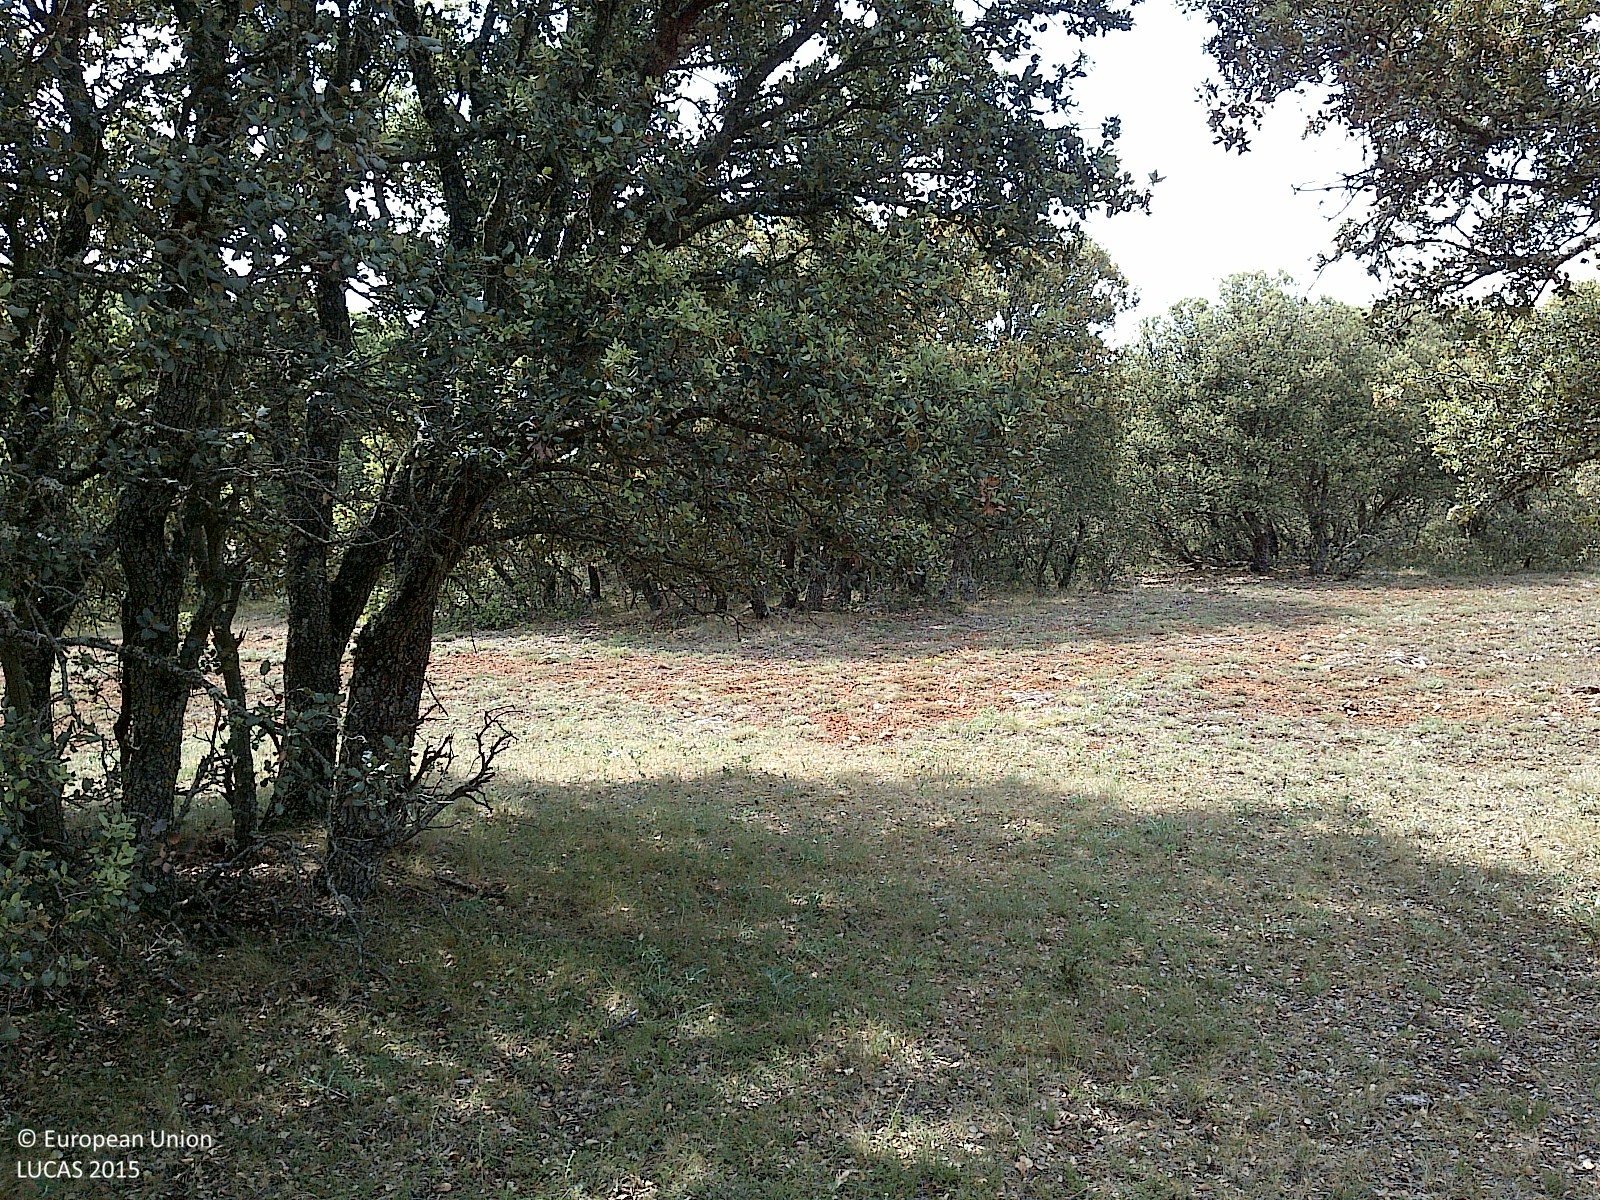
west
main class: Woodland
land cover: Broadleaved woodland
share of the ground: 50 - 75 %
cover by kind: broadleaved forest trees 50 %, herbaceous plants 40 %, consolidated bare surface 5 %, unconsolidated bare surface 5 %
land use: Forestry
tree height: < 5 m
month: June
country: ES
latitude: 41.7175
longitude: -2.1621
